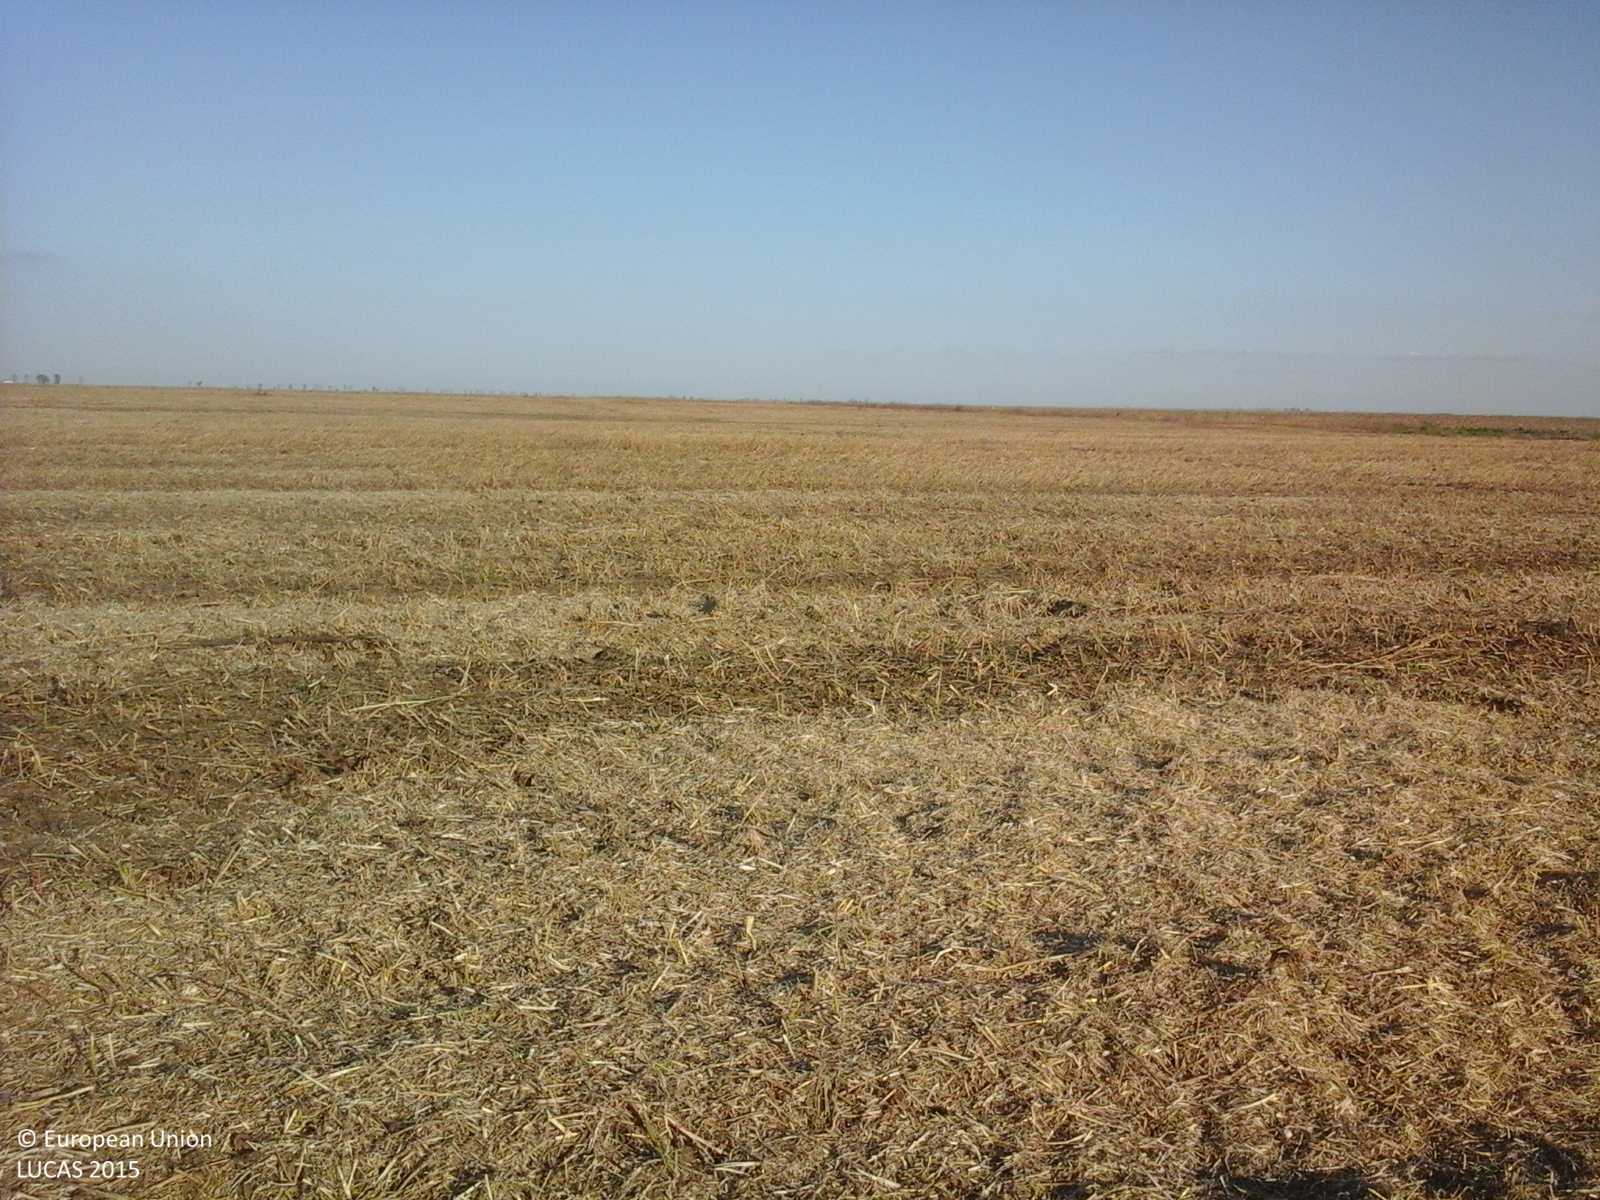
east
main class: Cropland
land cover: Soya
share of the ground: 25 - 50 %
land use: Agriculture (excluding fallow land and kitchen gardens)
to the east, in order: Soya; Shruby margins; Tracks; Spontaneously vegetated surfaces; Maize
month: October
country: RO
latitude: 45.3670
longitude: 27.4246
